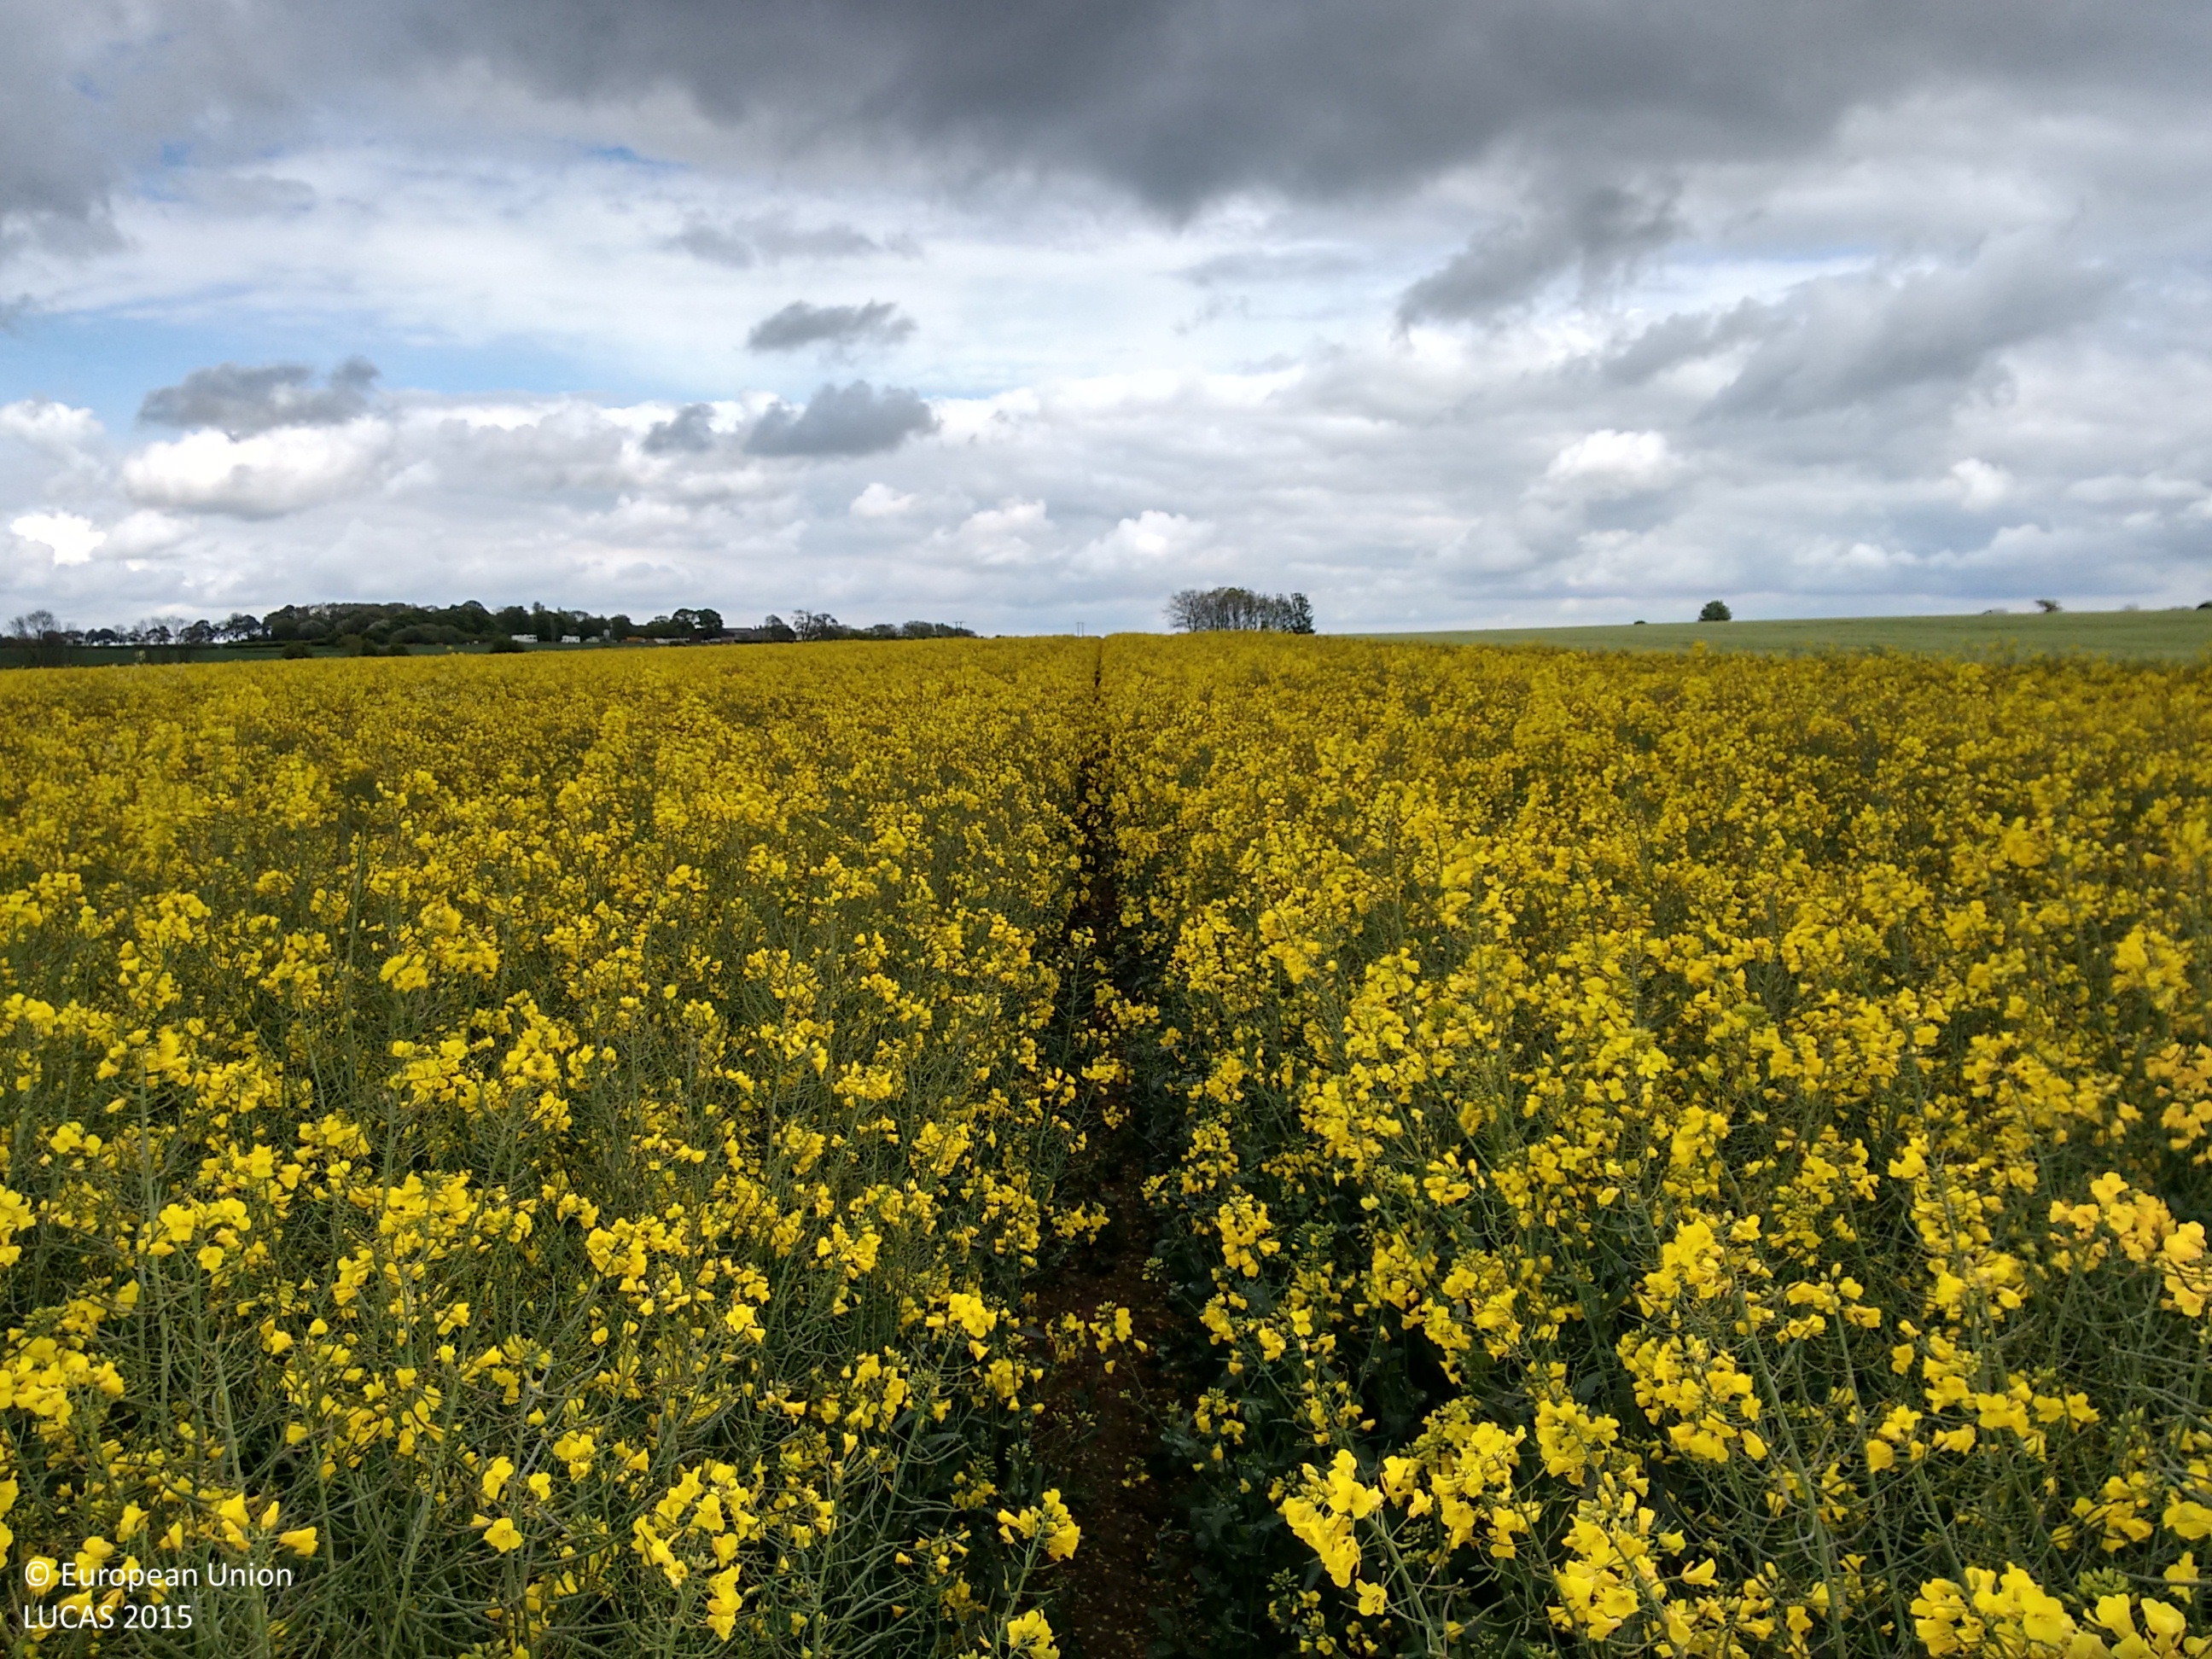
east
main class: Cropland
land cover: Rape and turnip rape
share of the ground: > 75 %
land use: Agriculture (excluding fallow land and kitchen gardens)
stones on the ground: < 10 %
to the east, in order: Rape and turnip rape
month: May
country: GB
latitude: 53.7183
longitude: -0.1403
